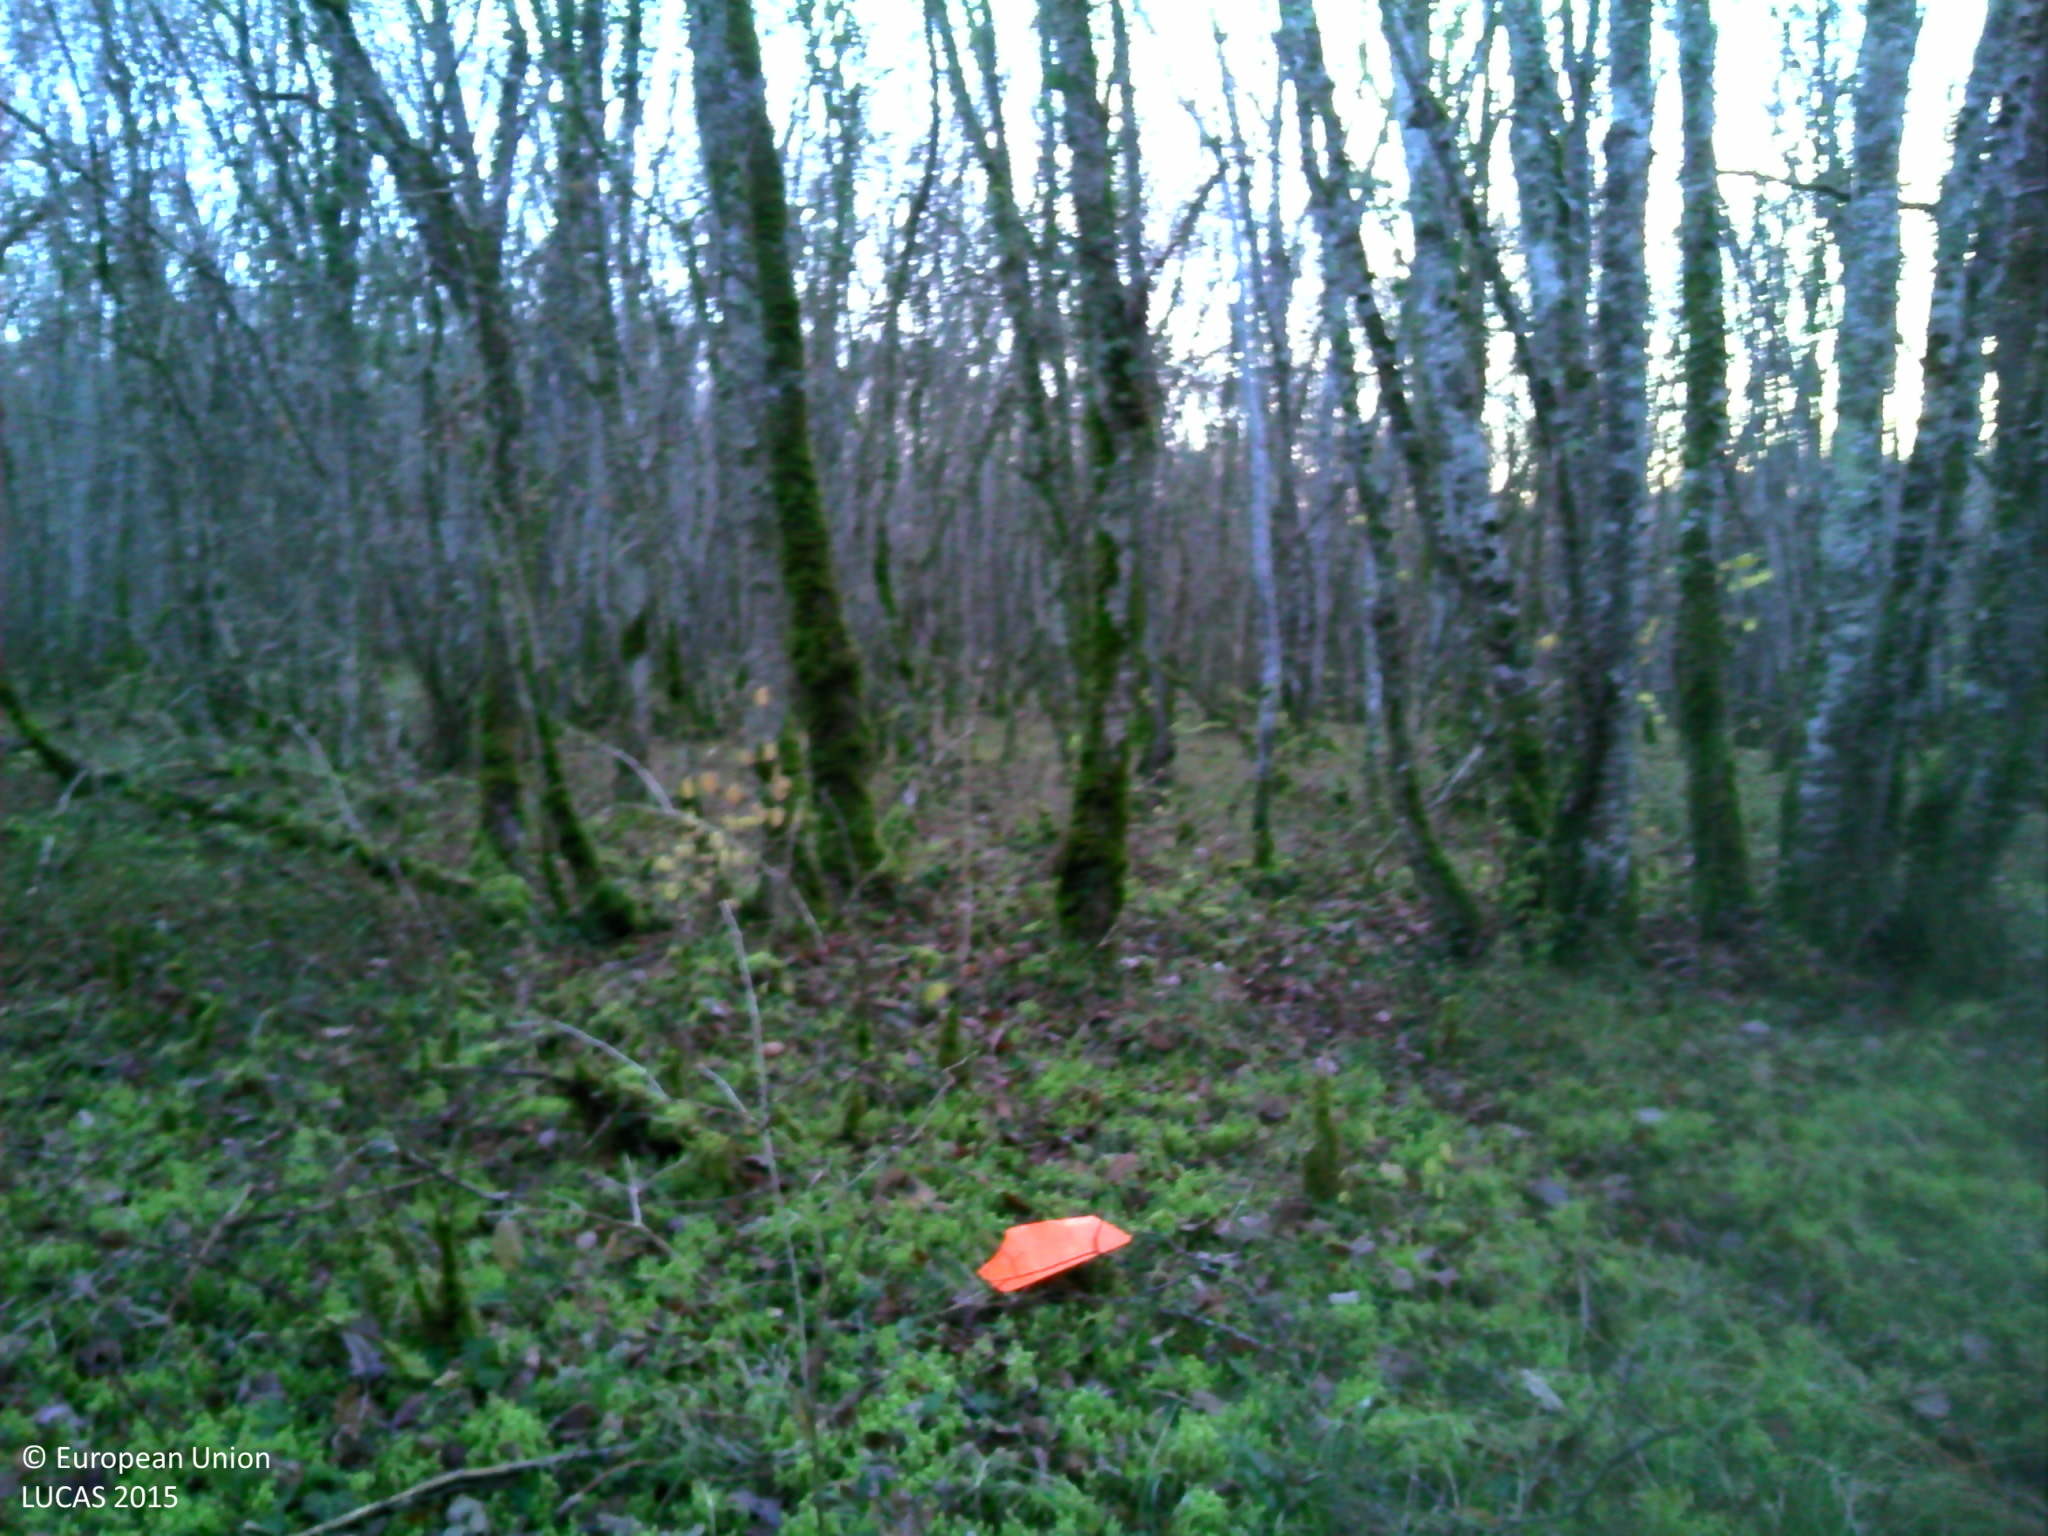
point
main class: Woodland
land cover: Broadleaved woodland
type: mesophytic deciduous forest
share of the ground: > 75 %
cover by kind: broadleaved forest trees 100 %
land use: Forestry
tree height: > 5 m
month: December
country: FR
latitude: 47.3829
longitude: 3.5193
